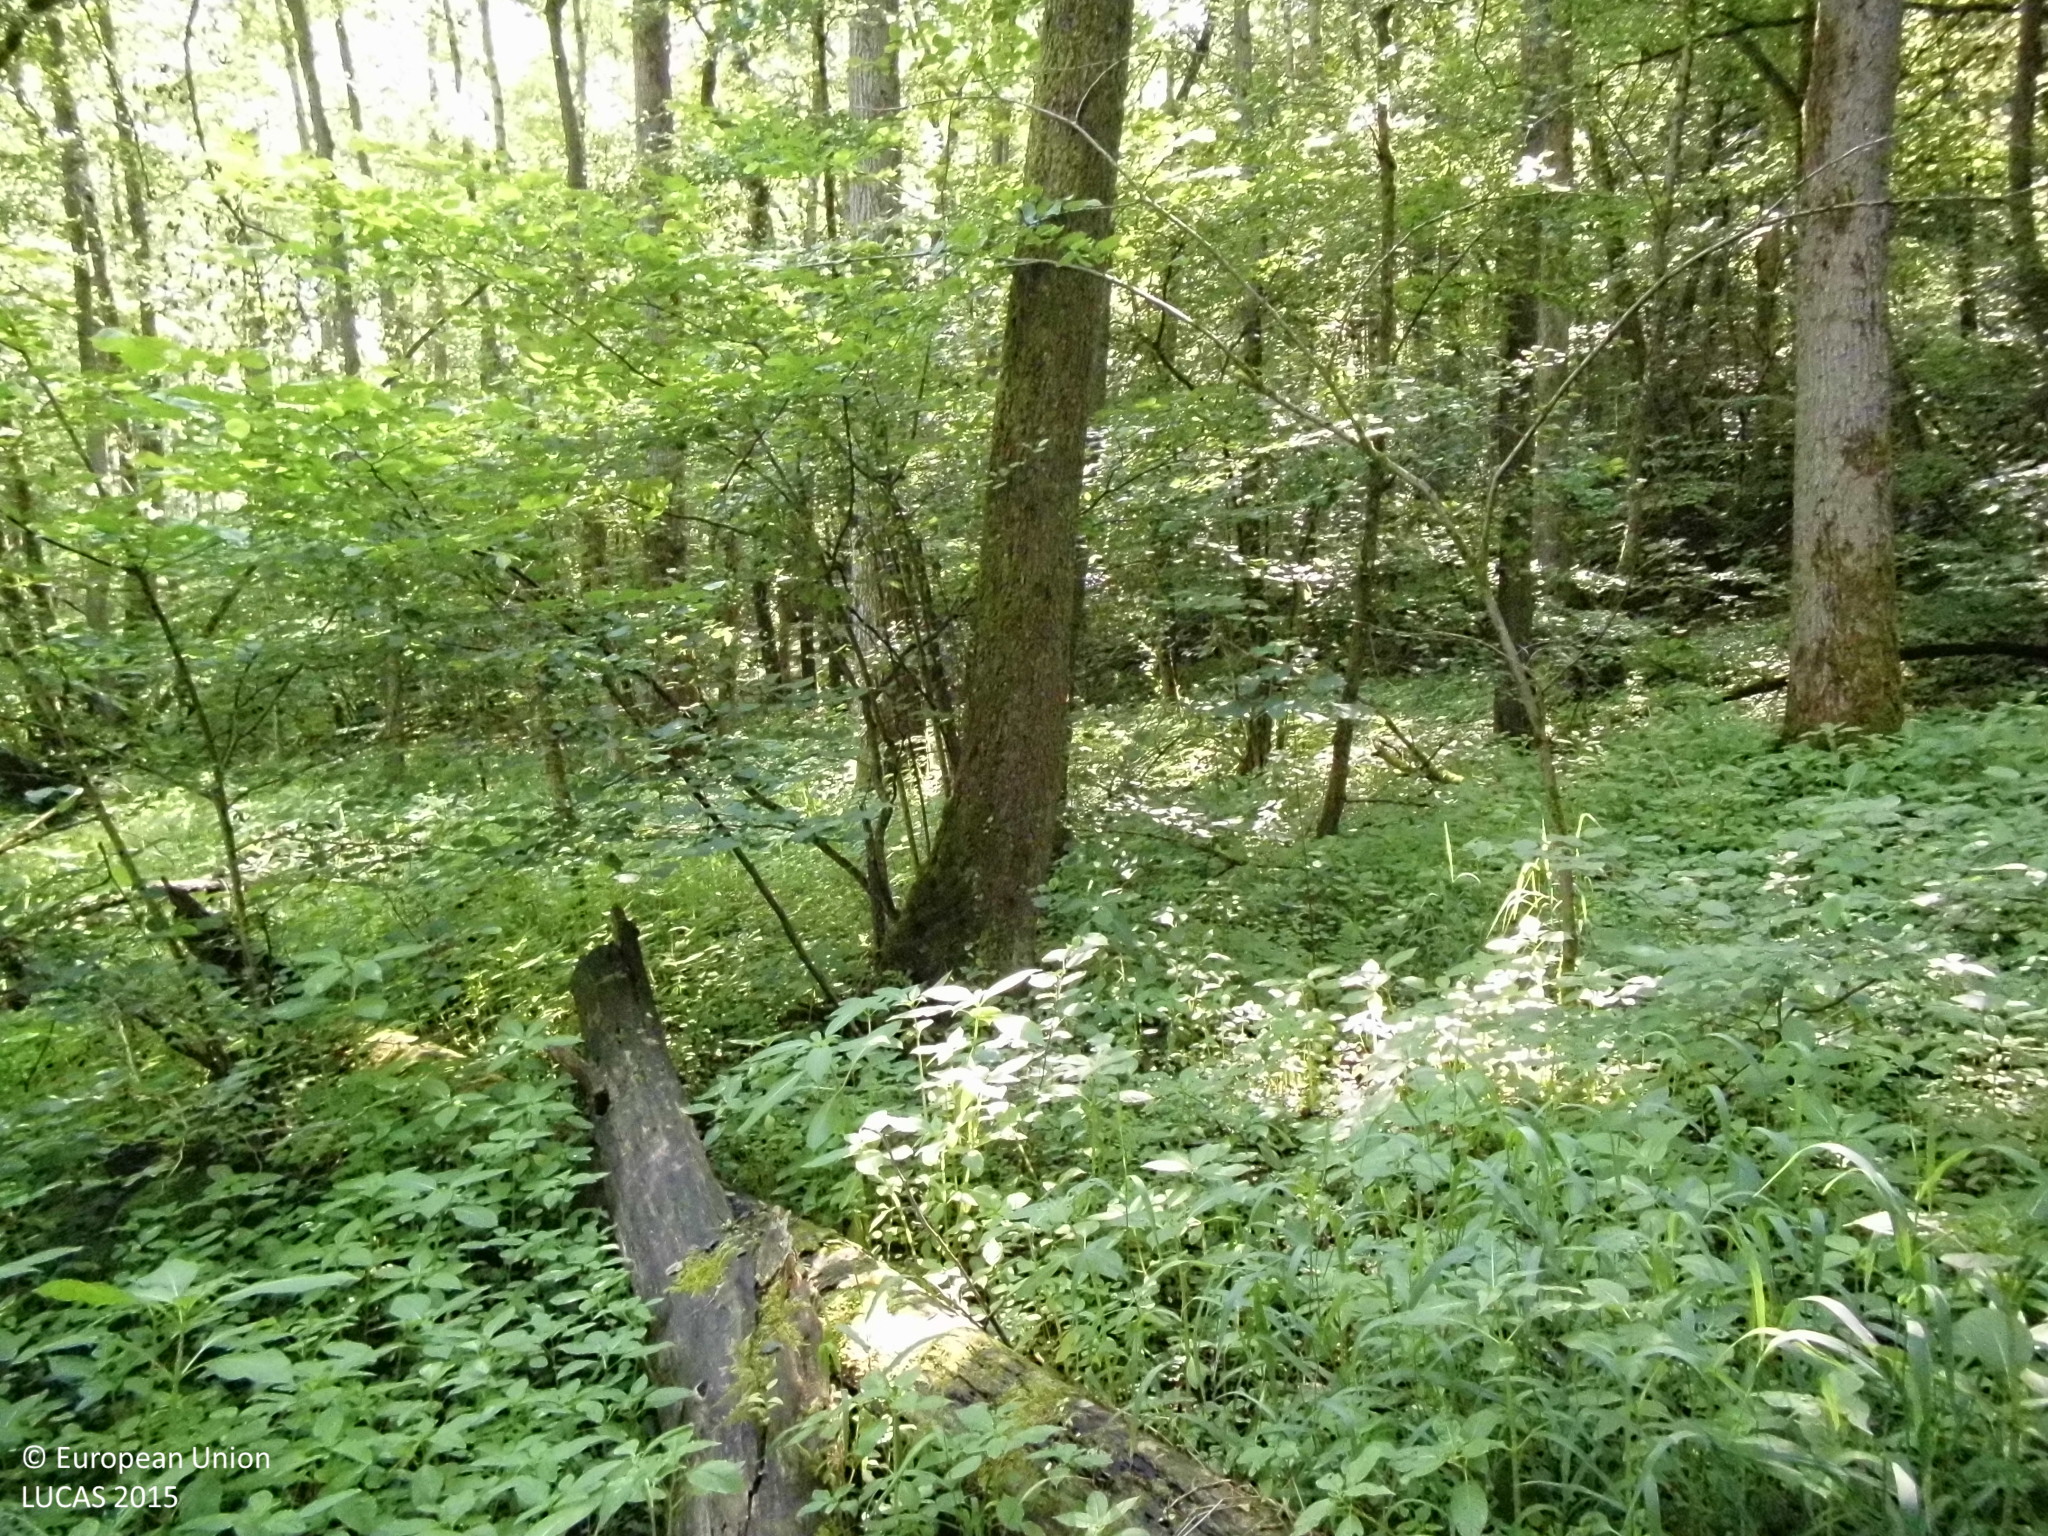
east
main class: Woodland
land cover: Broadleaved woodland
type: mesophytic deciduous forest
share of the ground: > 75 %
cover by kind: broadleaved forest trees 85 %, herbaceous plants 15 %
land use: Forestry
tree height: > 5 m
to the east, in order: Broadleaved woodland; Tracks; Broadleaved woodland; Tracks; Broadleaved woodland; Rivers and streams; Broadleaved woodland; Spruce dominated coniferous woodland; Spruce dominated mixed woodland; Spruce dominated coniferous woodland; Fences; Grassland without tree/shrub cover; Fences; Grass margins; Paved roads, cycling and walking lanes
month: June
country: DE
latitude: 50.9108
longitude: 7.4260
